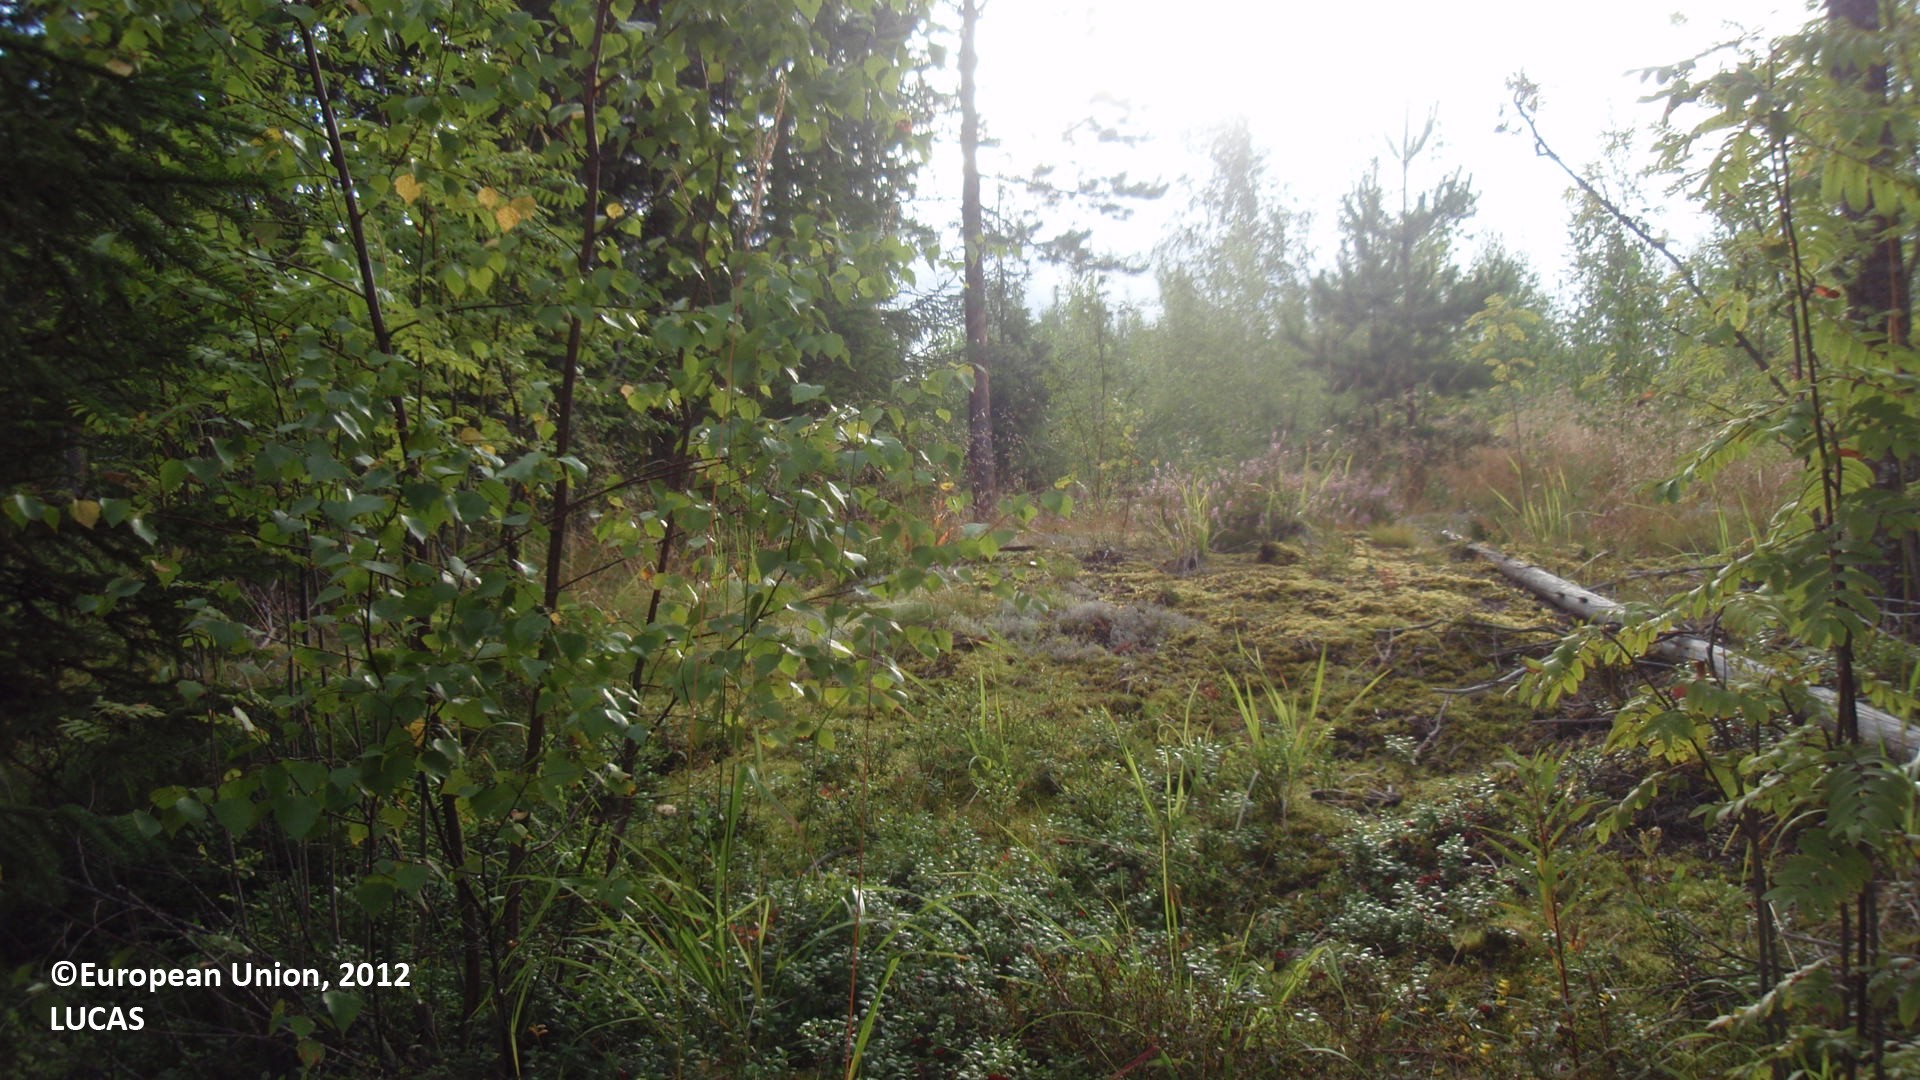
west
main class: Woodland
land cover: Spruce dominated mixed woodland
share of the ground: 50 - 75 %
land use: Forestry
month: August
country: FI
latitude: 60.9978
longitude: 27.6601
